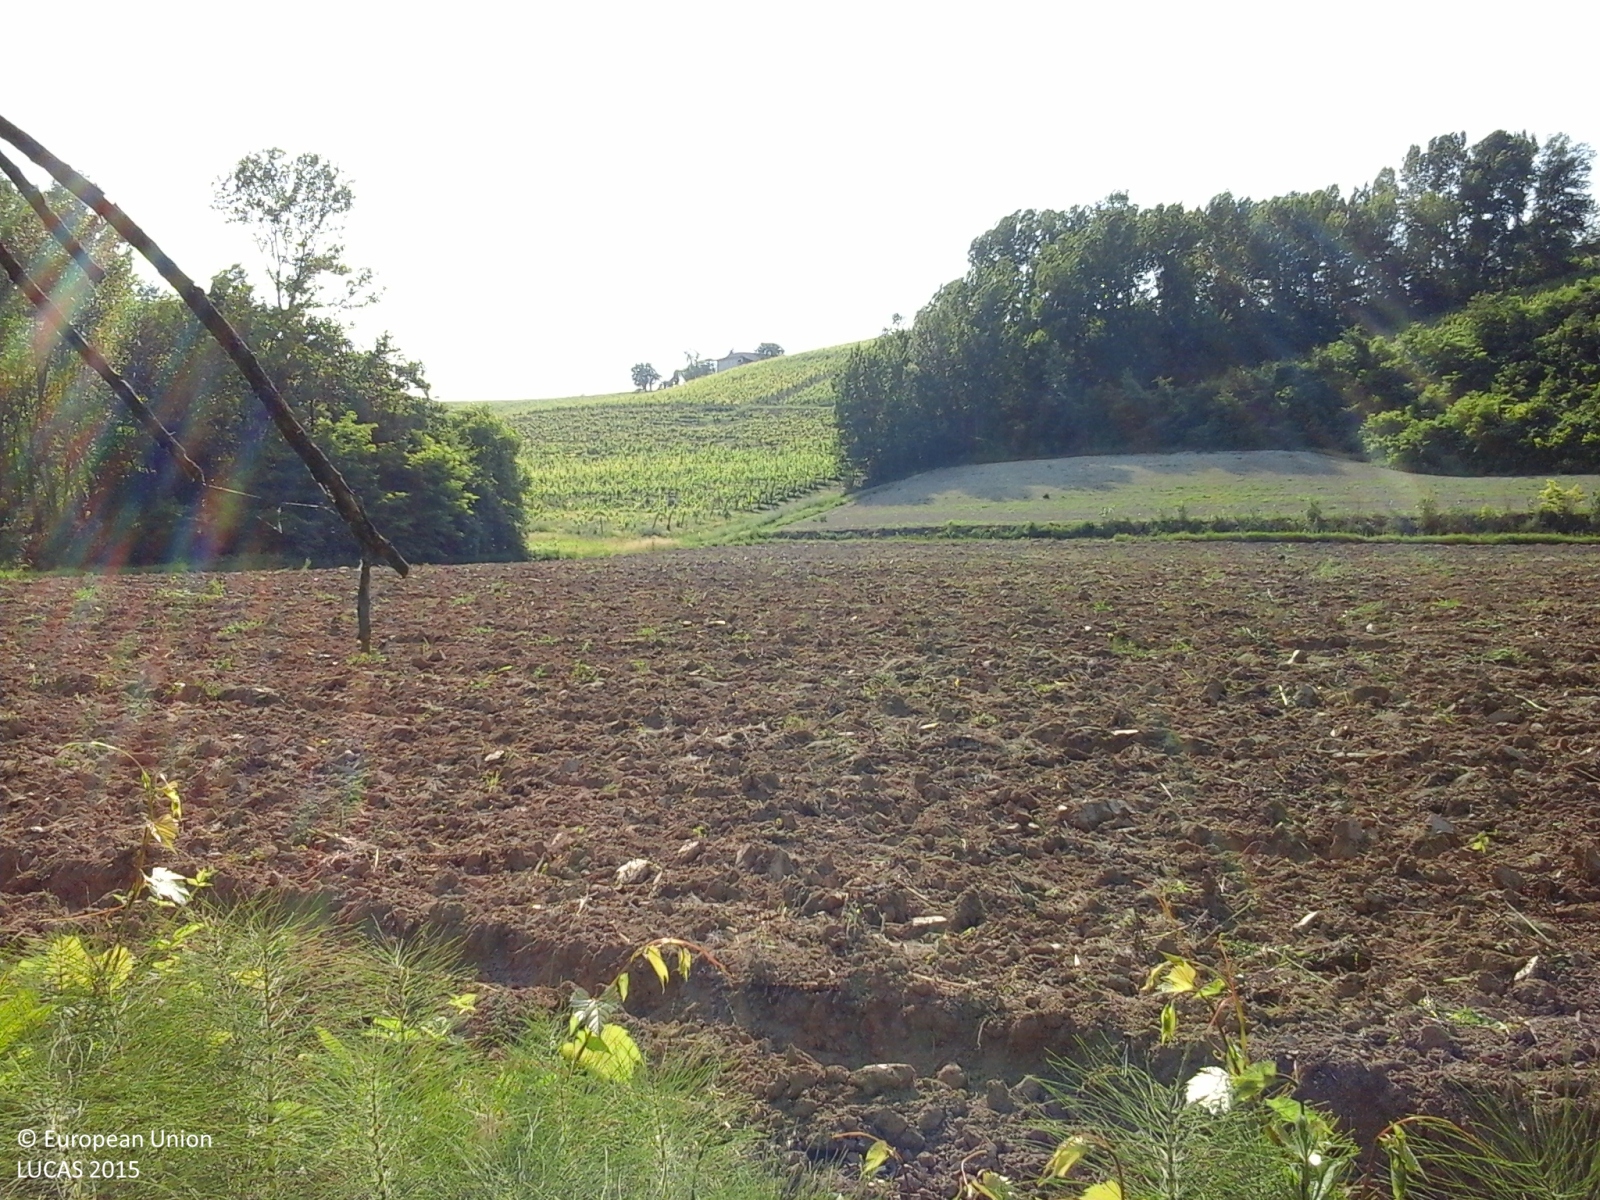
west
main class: Woodland
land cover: Broadleaved woodland
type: mesophytic deciduous forest
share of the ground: > 75 %
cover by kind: broadleaved forest trees 95 %, shrubs 5 %
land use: Forestry
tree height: > 5 m
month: May
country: IT
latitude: 44.7711
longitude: 8.3985
